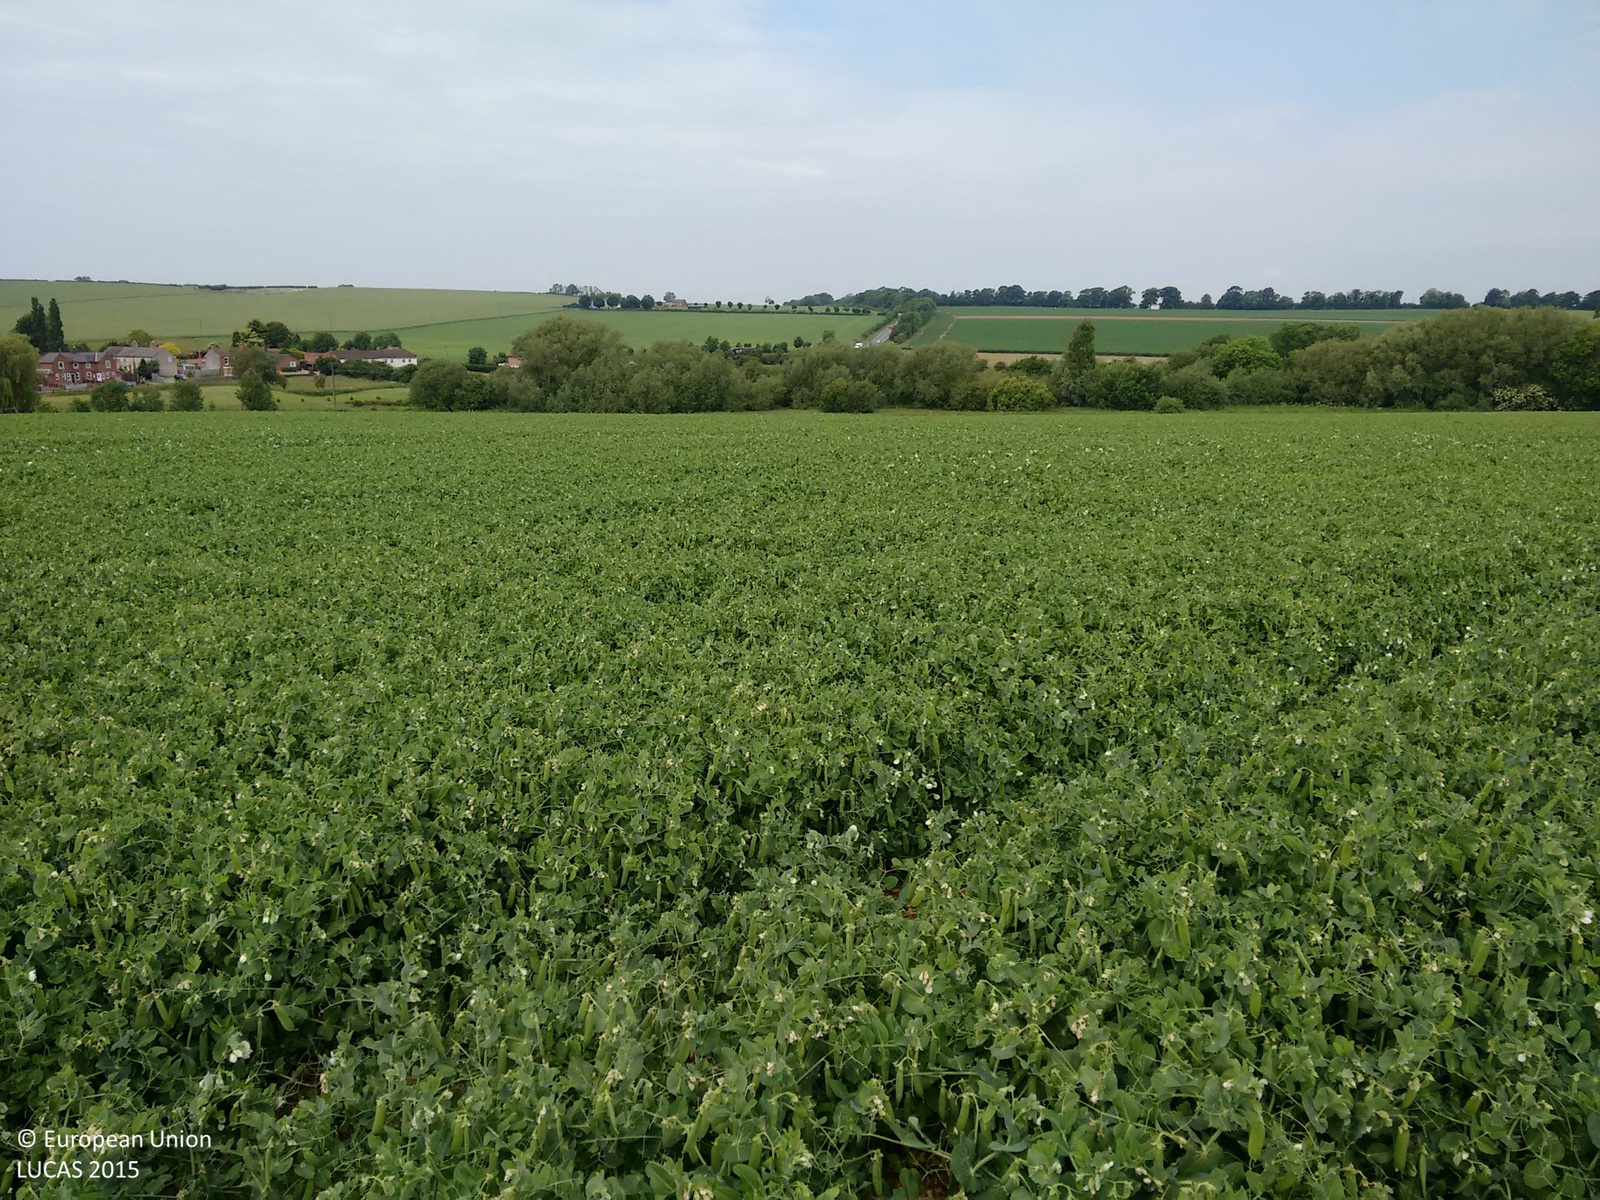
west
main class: Cropland
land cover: Dry pulses
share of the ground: > 75 %
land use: Agriculture (excluding fallow land and kitchen gardens)
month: June
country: GB
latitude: 52.9797
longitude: -0.5080
